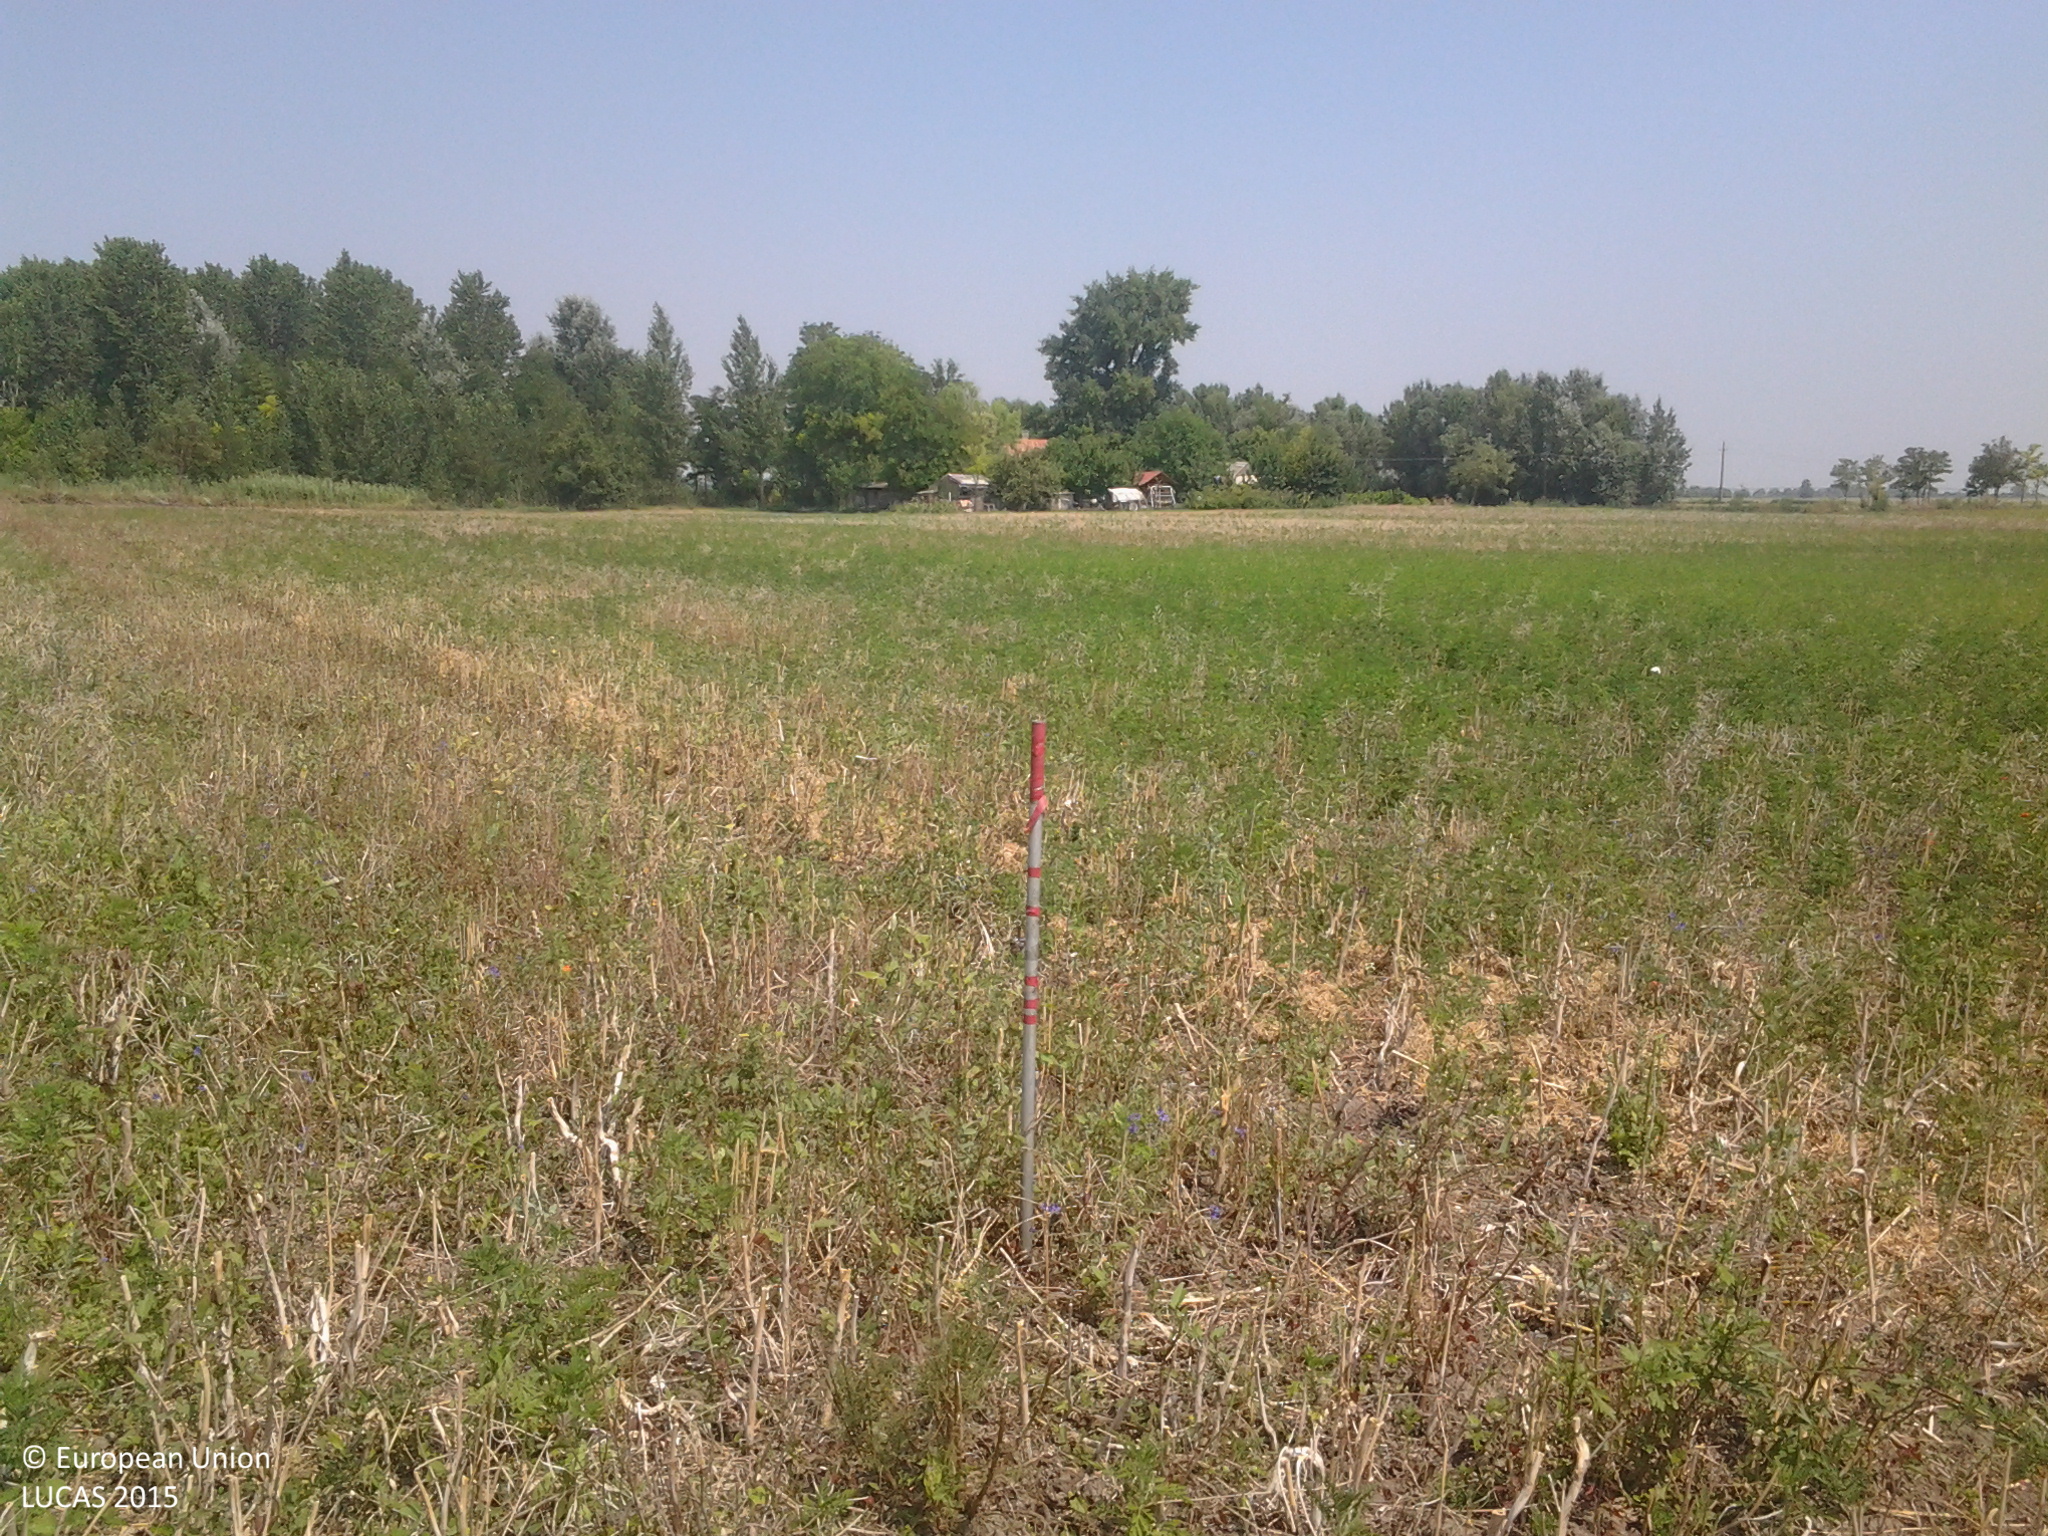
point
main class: Cropland
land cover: Rape and turnip rape
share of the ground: > 75 %
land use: Agriculture (excluding fallow land and kitchen gardens)
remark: Harvested field
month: July
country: HU
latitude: 46.8545
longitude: 19.0521
